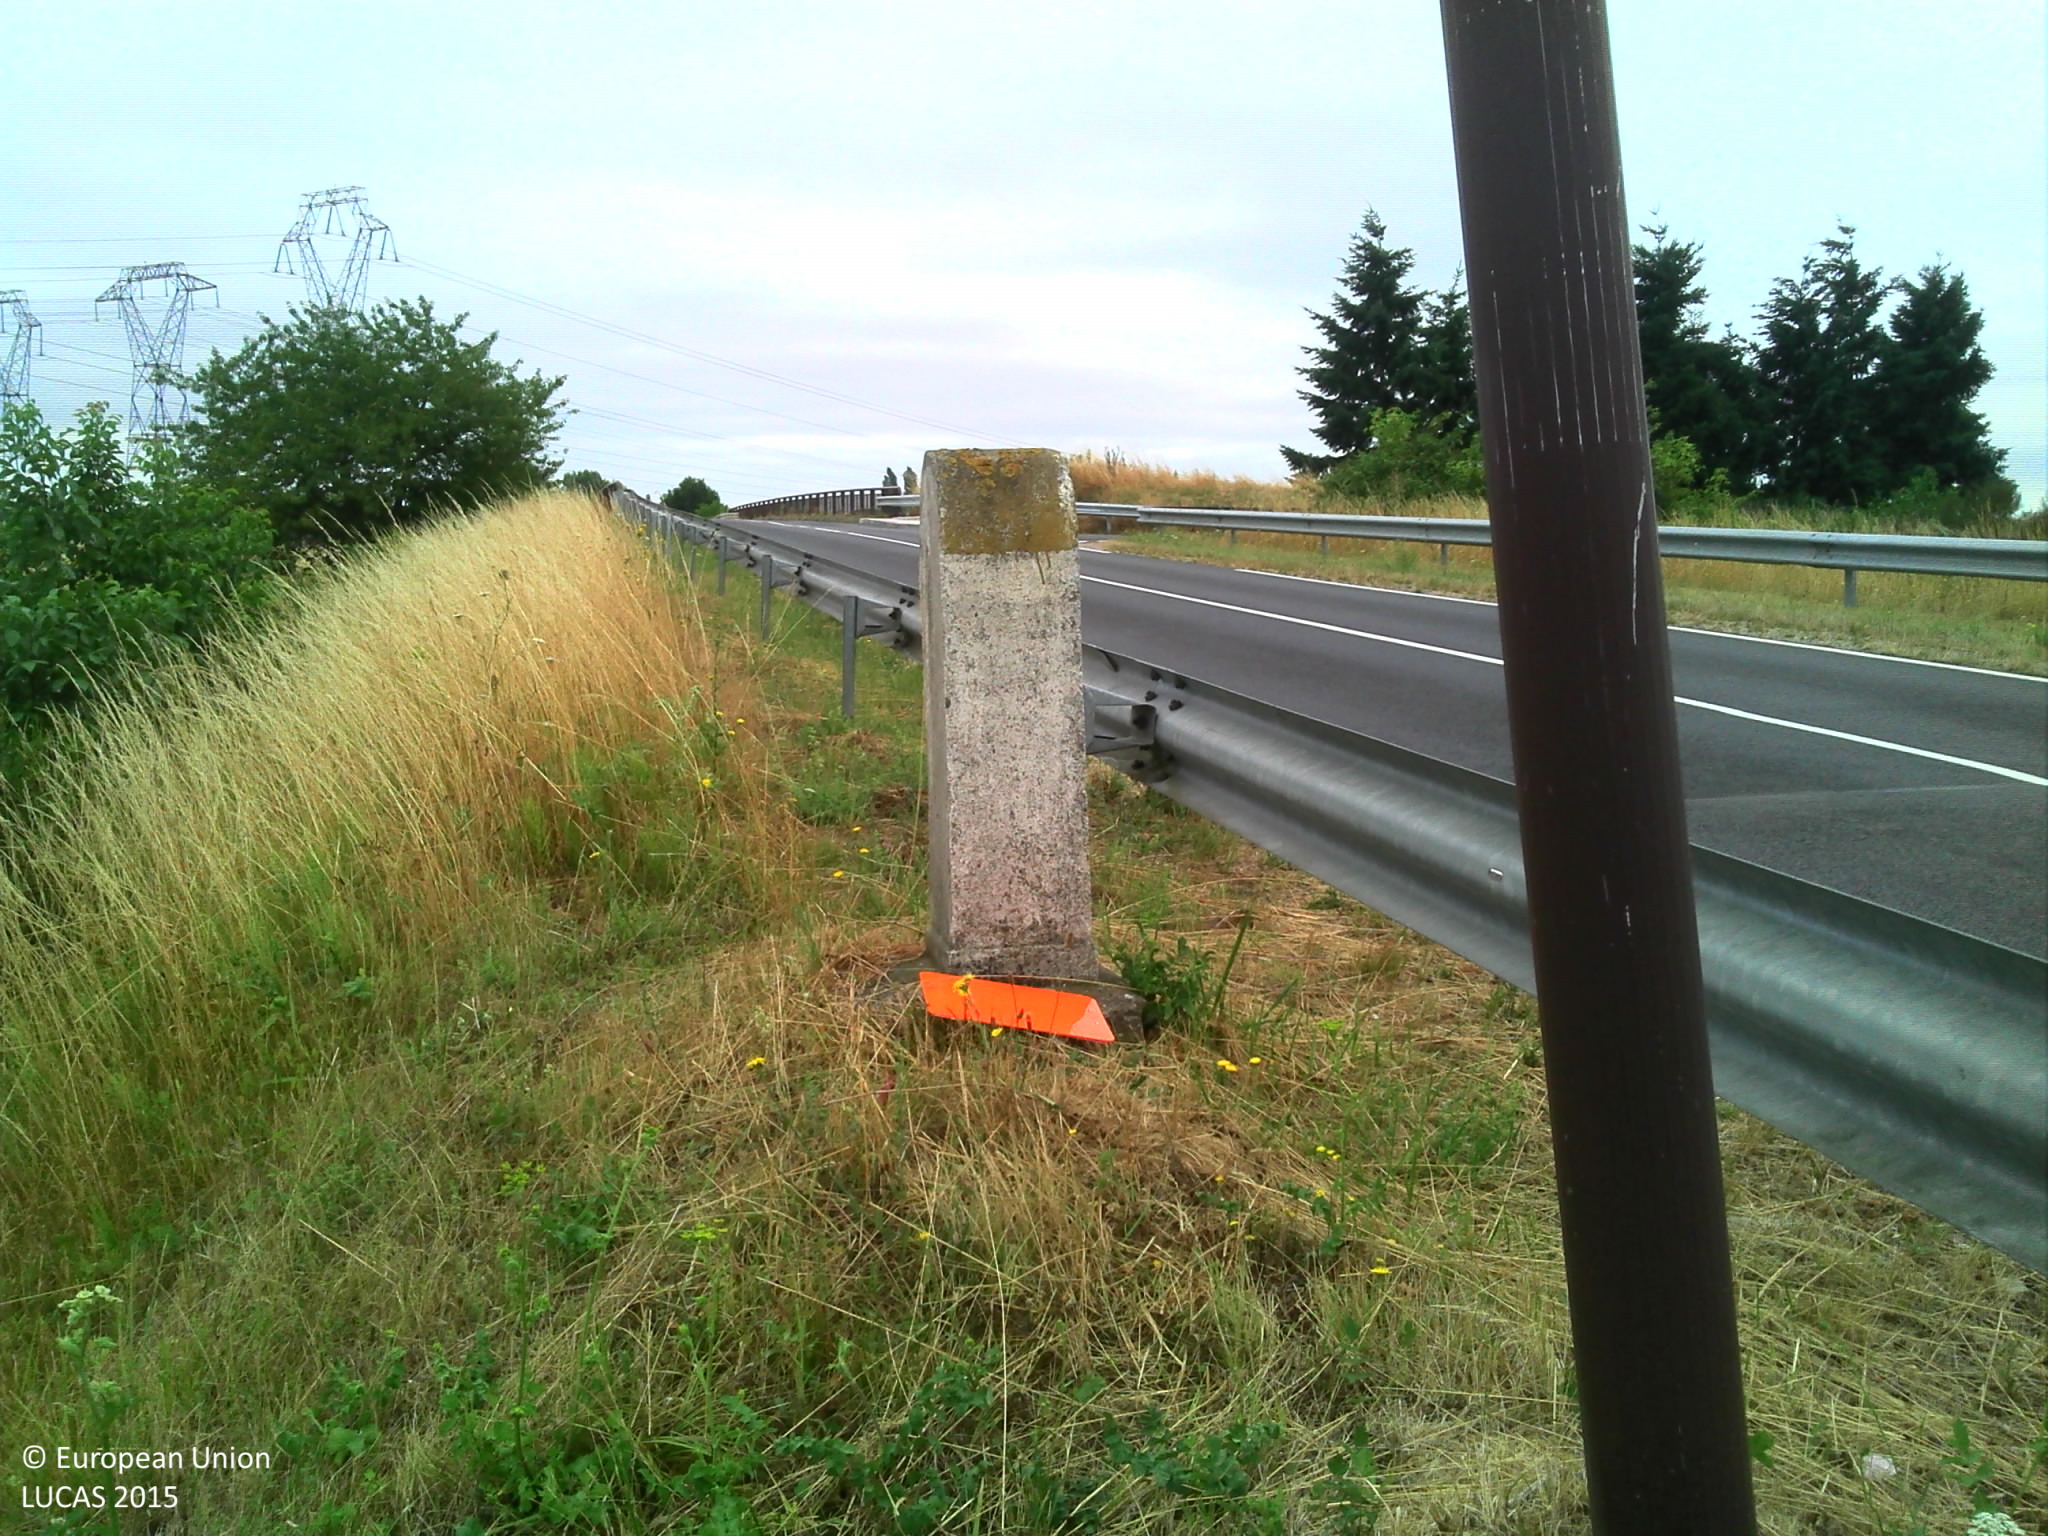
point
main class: Grassland
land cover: Grassland without tree/shrub cover
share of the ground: > 75 %
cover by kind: herbaceous plants 70 %, consolidated bare surface 10 %, unconsolidated bare surface 10 %, shrubs 5 %, lichens and mosses 5 %
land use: Road transport
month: July
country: FR
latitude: 48.5281
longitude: 2.5010
